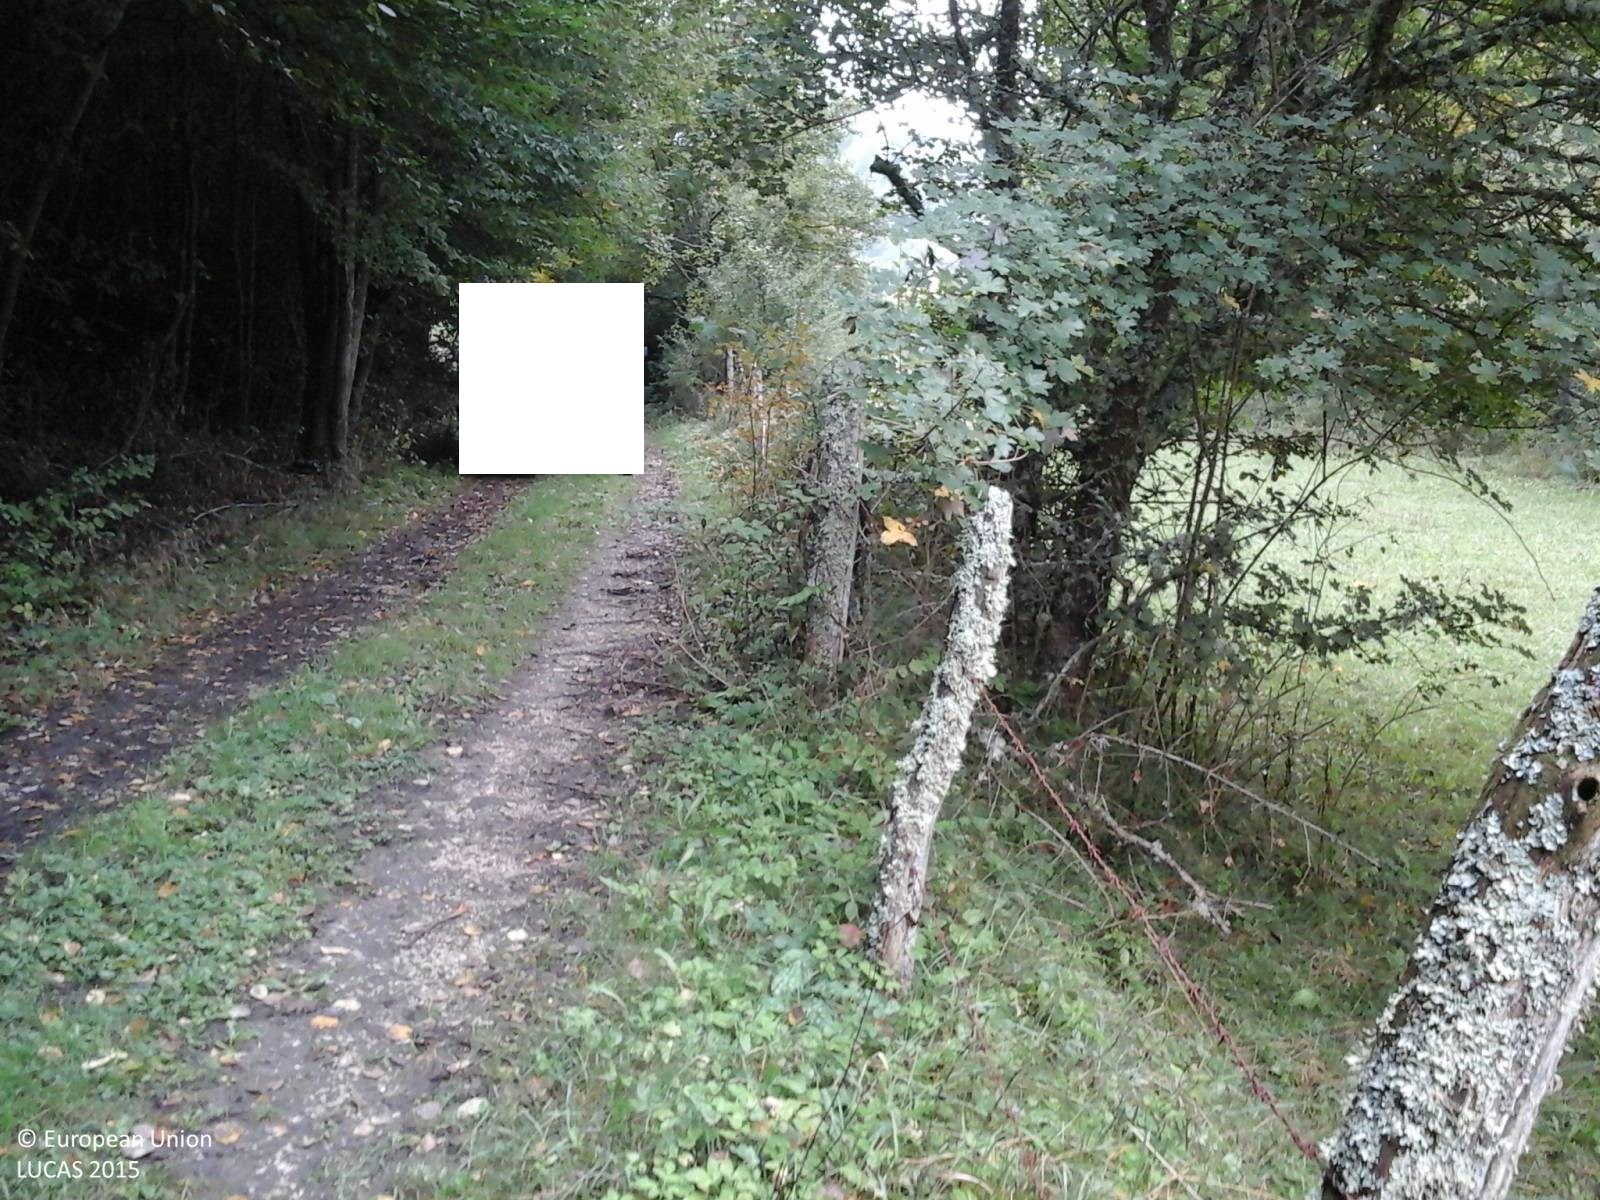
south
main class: Grassland
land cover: Grassland without tree/shrub cover
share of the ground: > 75 %
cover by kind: herbaceous plants 100 %
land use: Agriculture (excluding fallow land and kitchen gardens)
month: October
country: IT
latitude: 42.6021
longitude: 13.2443
